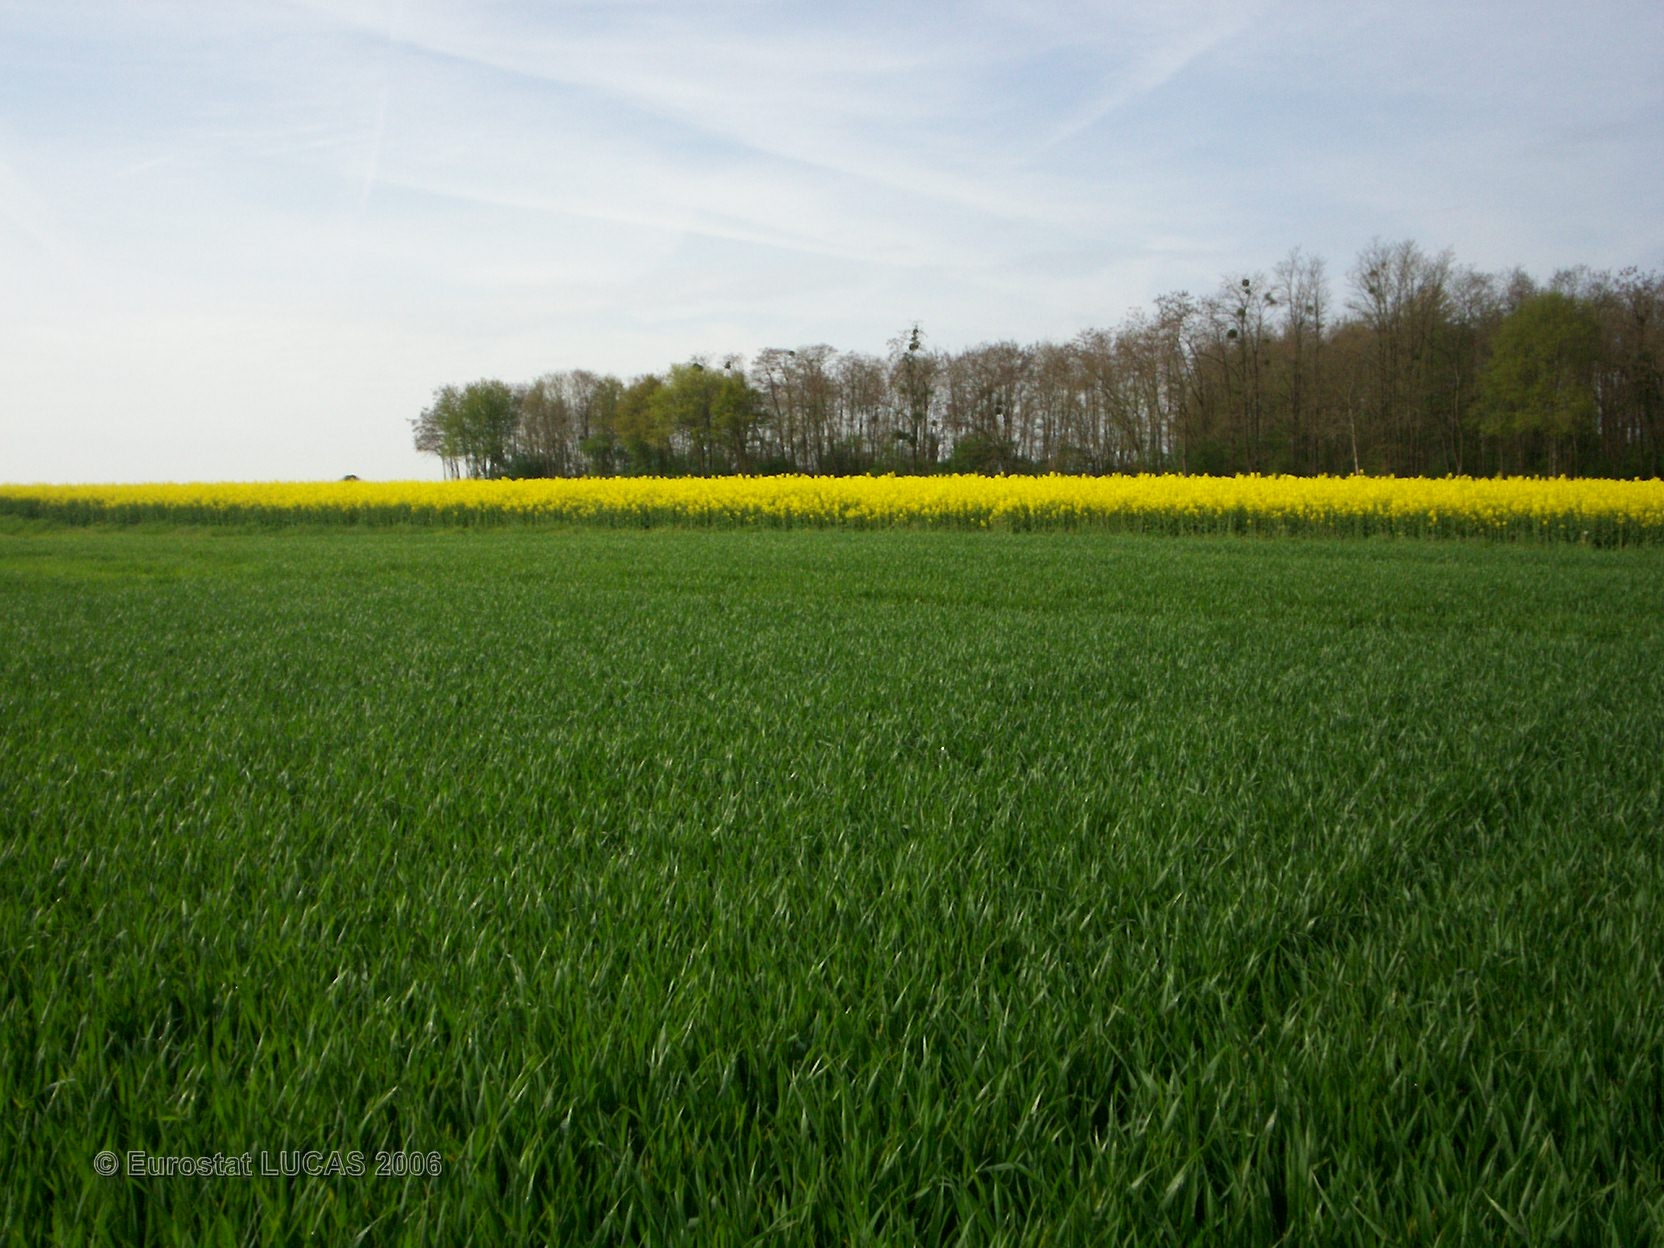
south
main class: Cropland
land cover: Common wheat
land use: Agriculture (excluding fallow land and kitchen gardens)
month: May
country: FR
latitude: 47.2639
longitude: 3.0566
